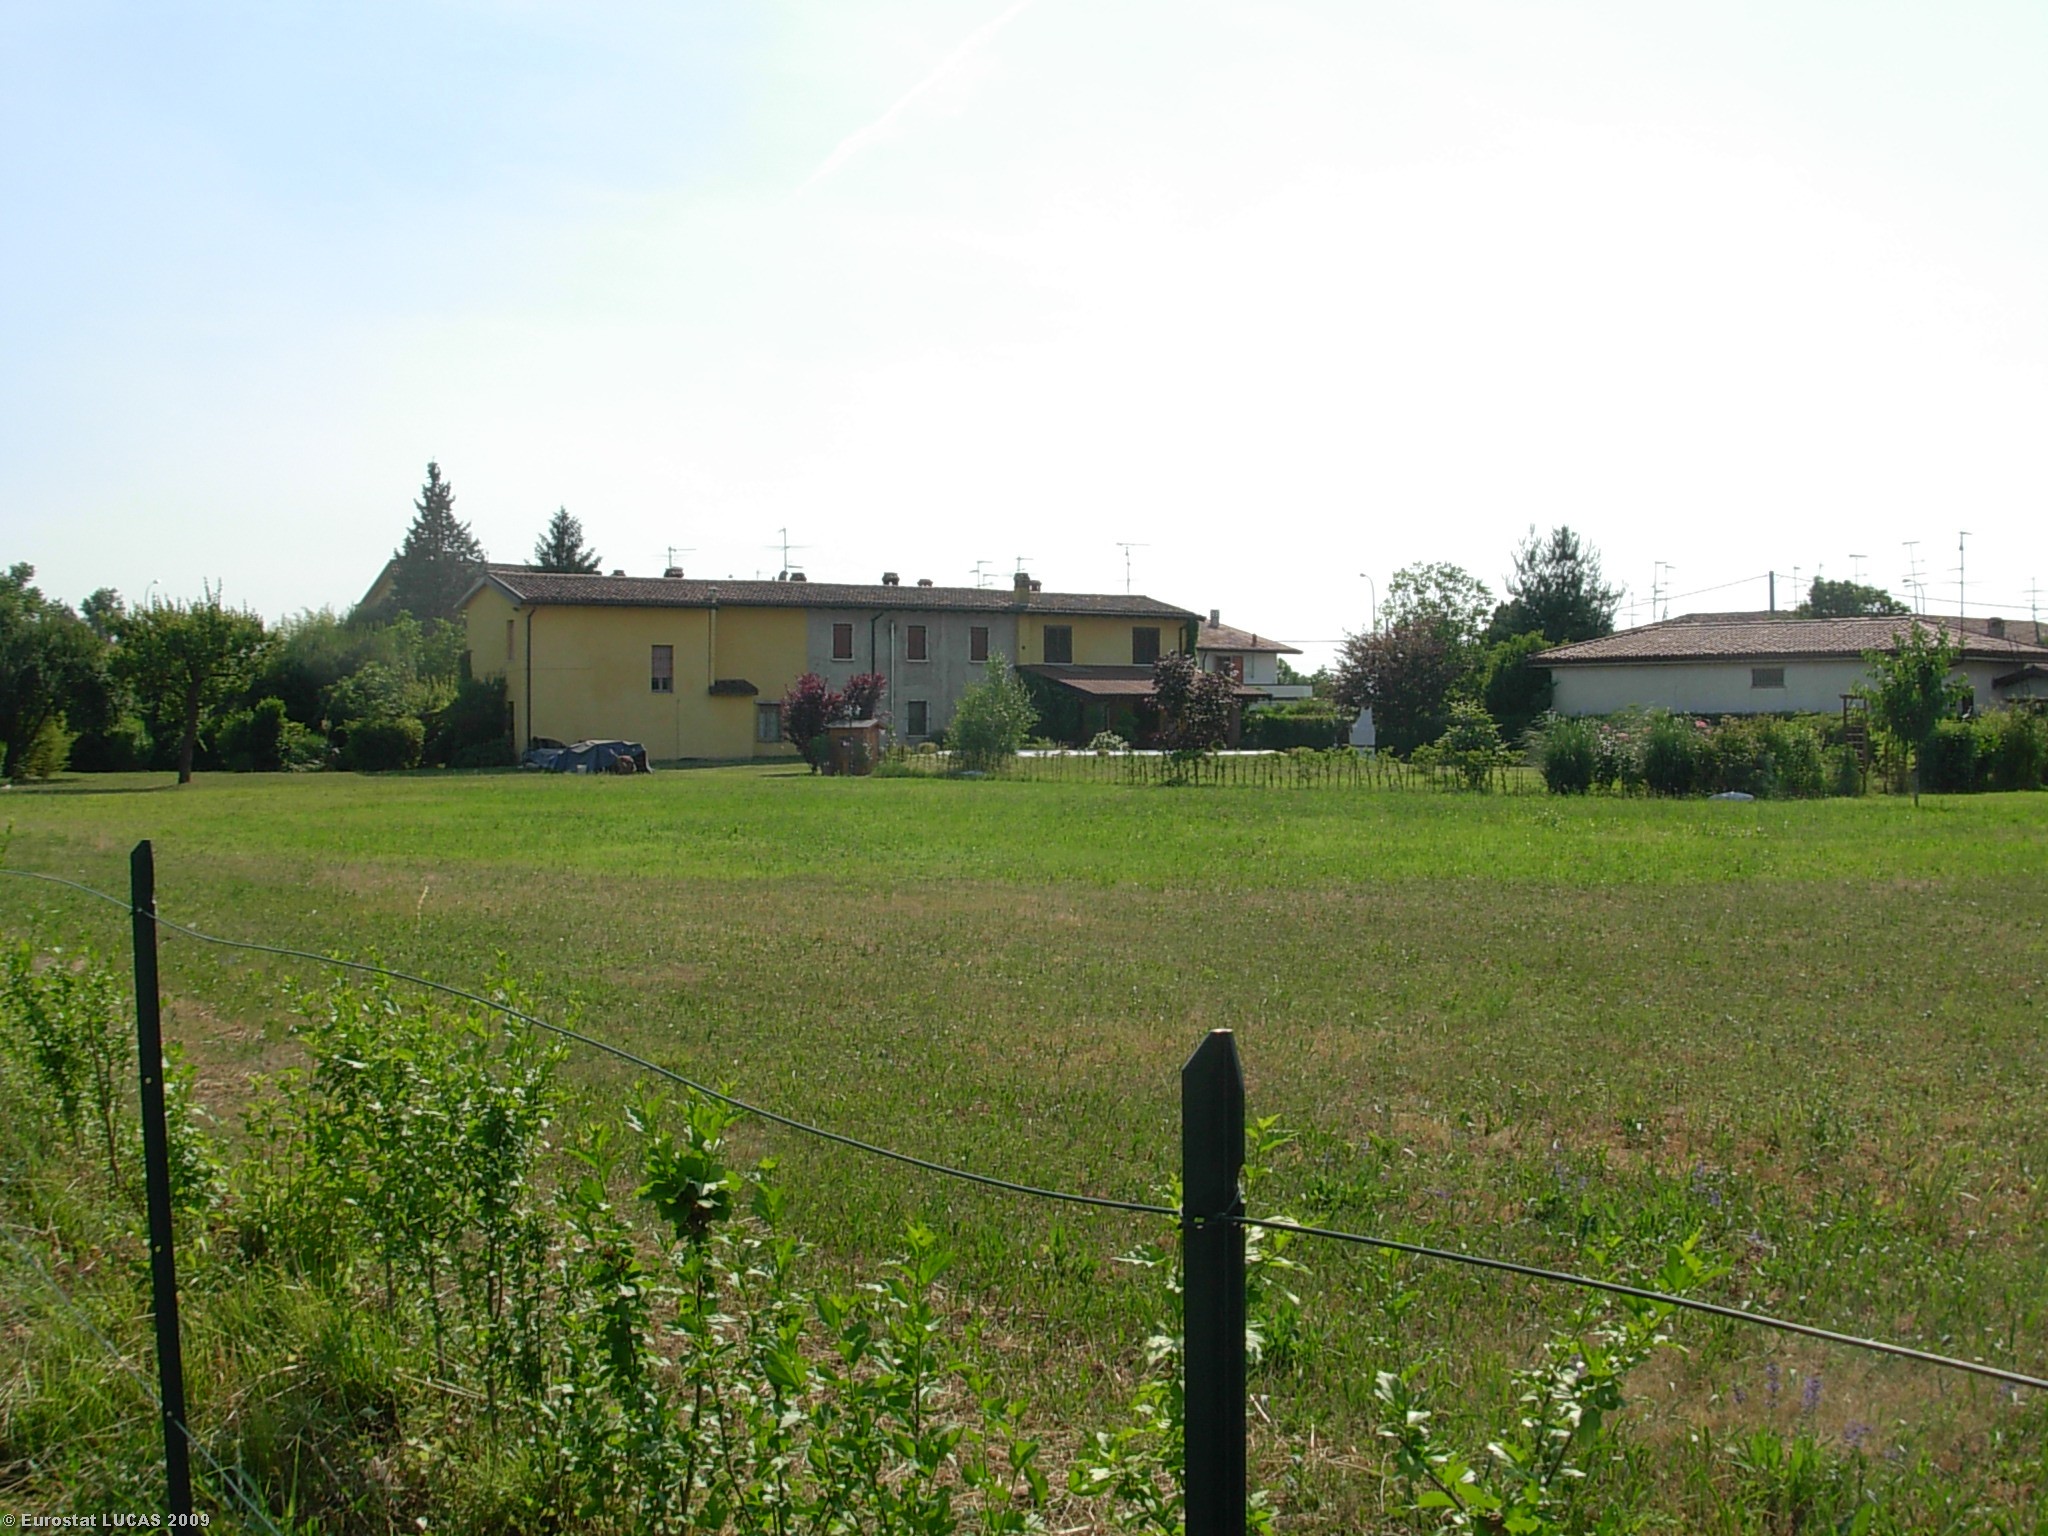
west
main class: Grassland
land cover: Grassland with sparse tree/shrub cover
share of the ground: > 75 %
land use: Residential
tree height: < 5 m
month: June
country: IT
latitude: 45.4858
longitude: 10.3448
